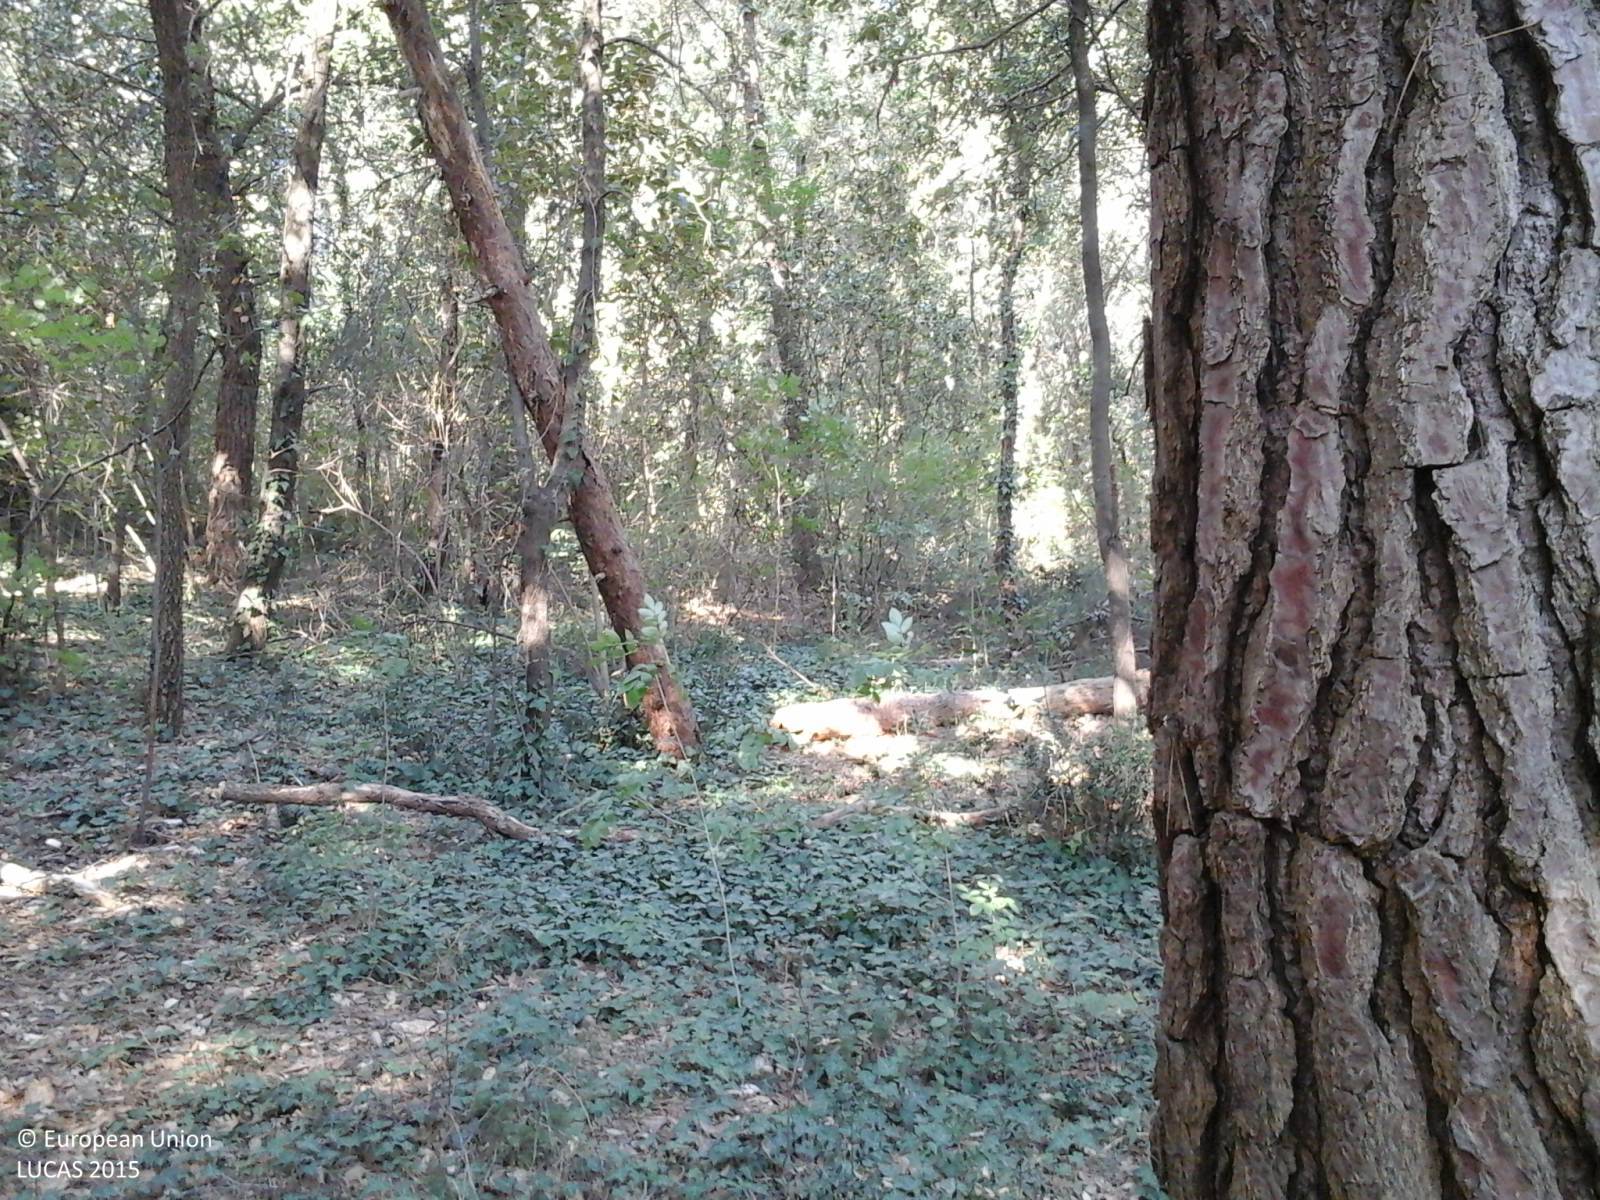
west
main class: Woodland
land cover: Other mixed woodland
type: thermophilous deciduous forest
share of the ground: > 75 %
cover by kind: coniferous forest trees 60 %, broadleaved forest trees 40 %
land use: Forestry
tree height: > 5 m
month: September
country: IT
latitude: 43.0967
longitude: 12.3398
